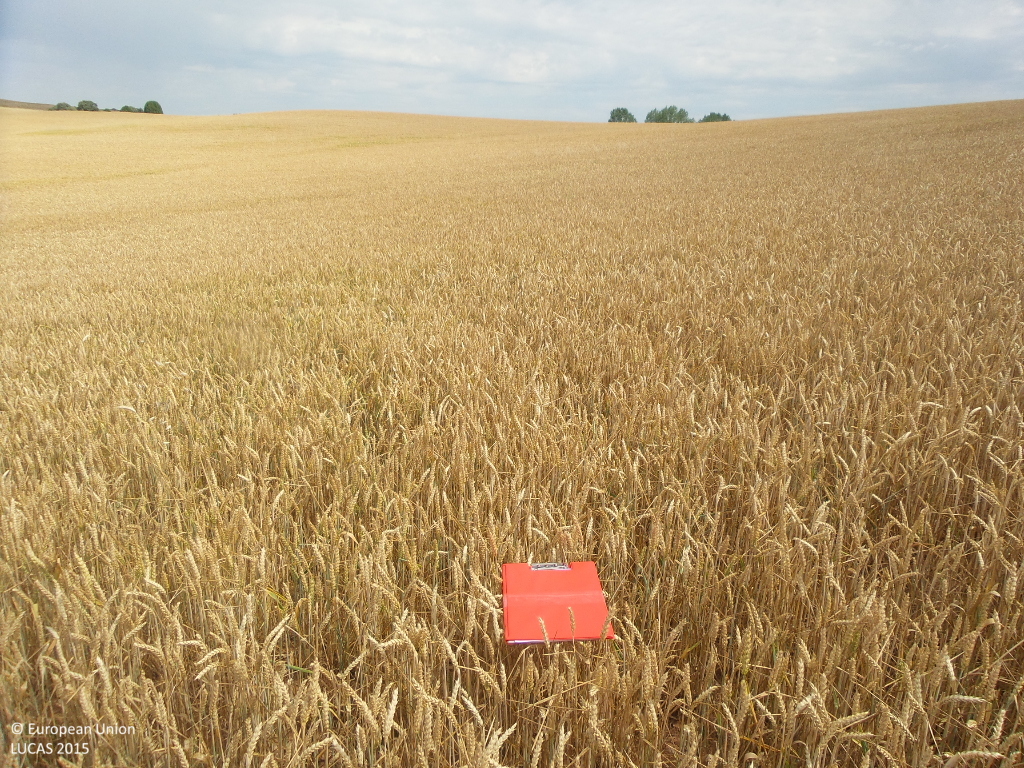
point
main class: Cropland
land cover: Common wheat
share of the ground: > 75 %
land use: Agriculture (excluding fallow land and kitchen gardens)
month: June
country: ES
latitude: 41.5321
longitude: -3.0466
